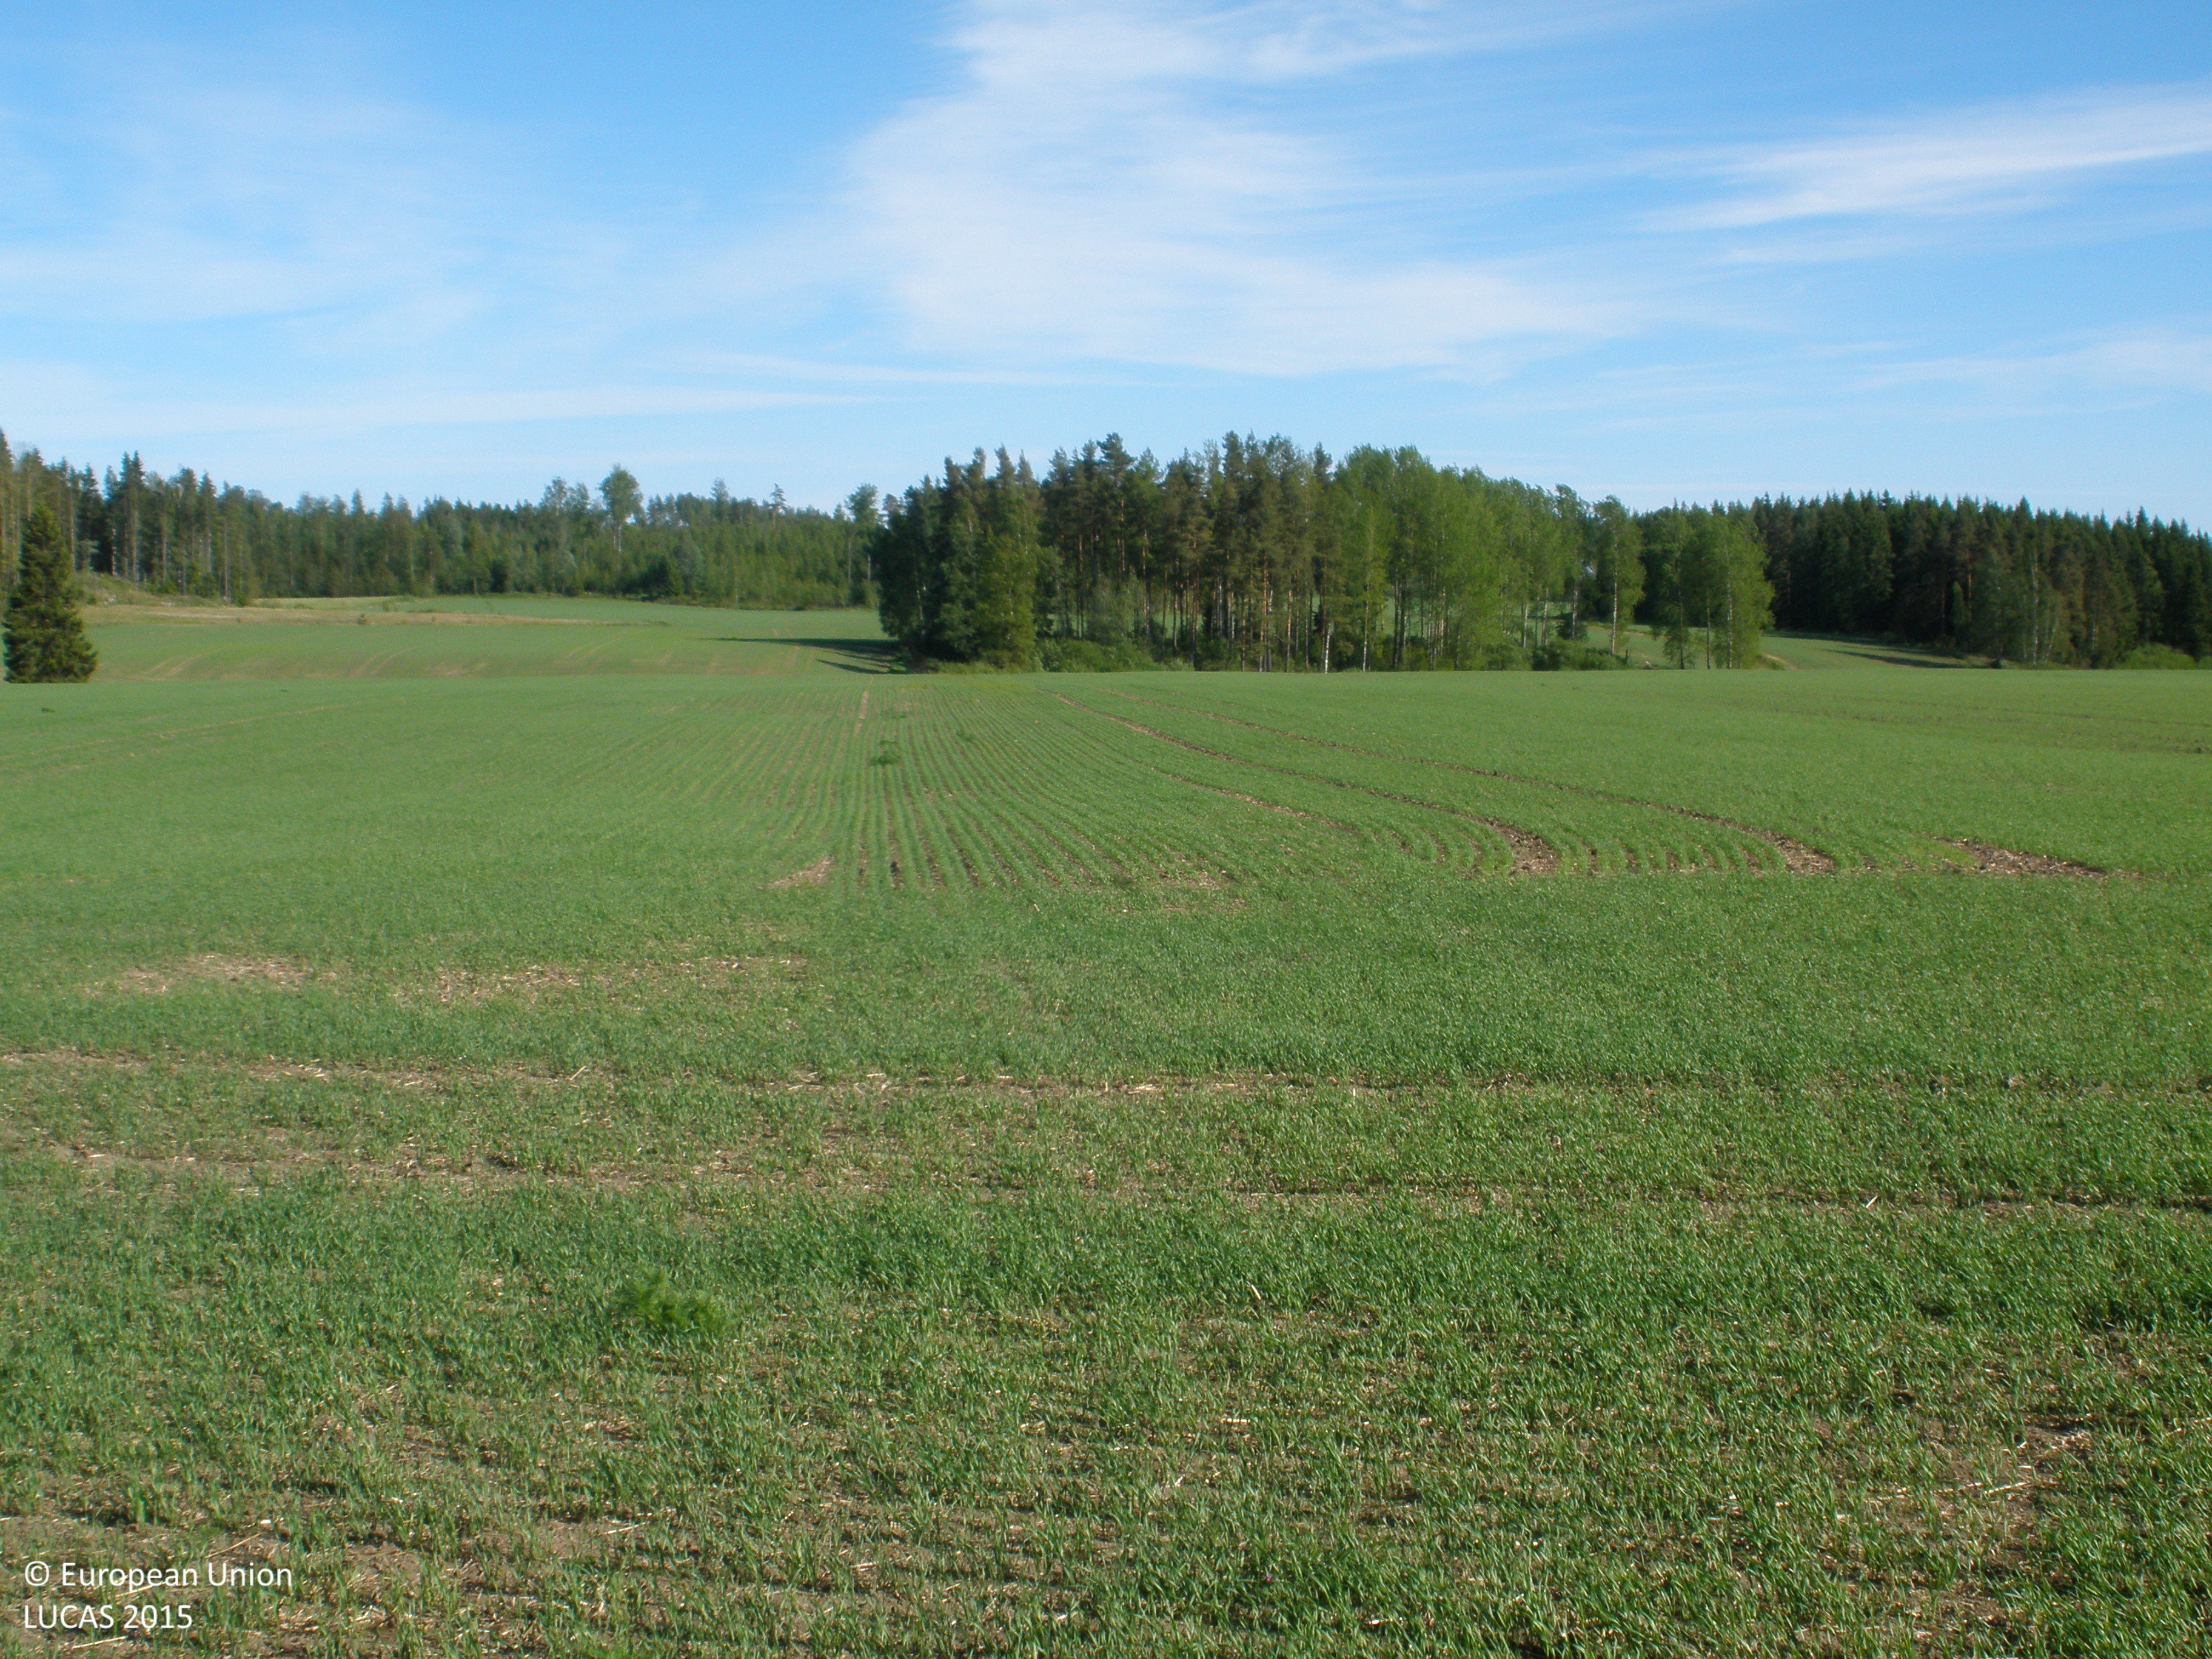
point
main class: Cropland
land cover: Common wheat
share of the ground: > 75 %
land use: Agriculture (excluding fallow land and kitchen gardens)
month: June
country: FI
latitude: 60.7613
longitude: 23.4264
